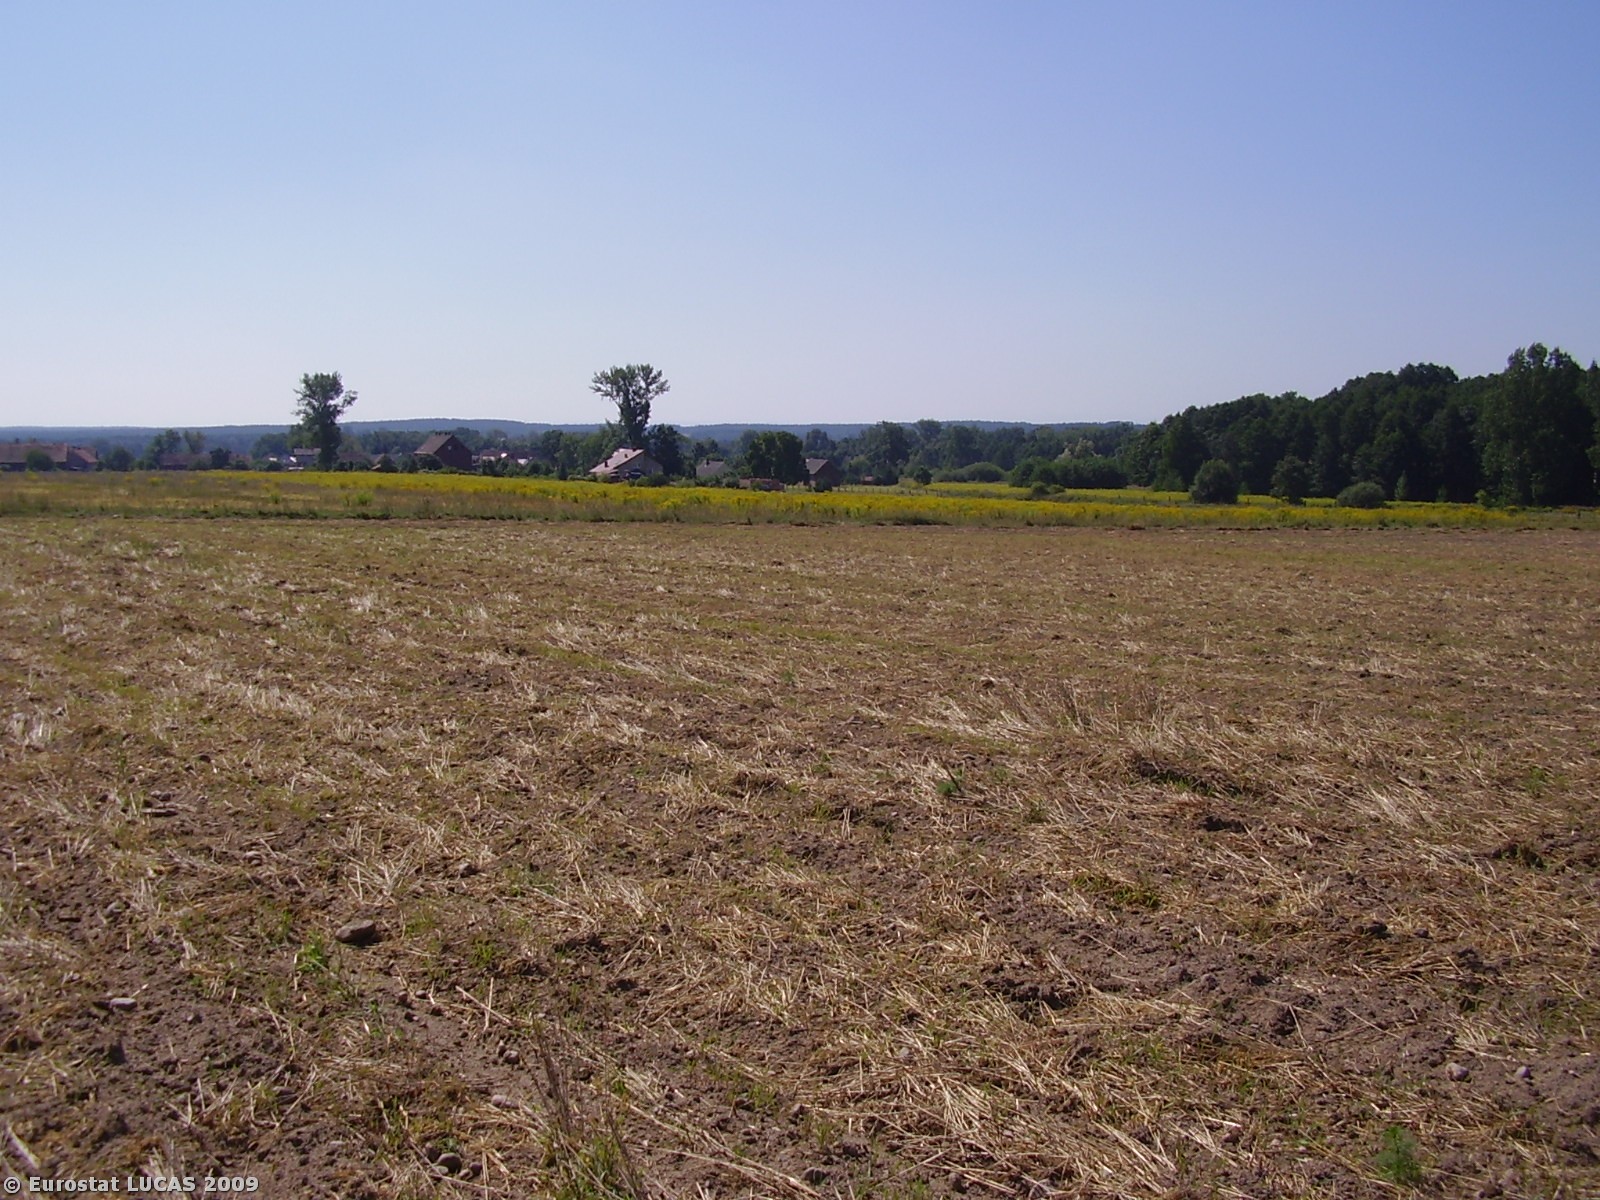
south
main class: Cropland
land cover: Rye
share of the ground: < 10 %
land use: Agriculture (excluding fallow land and kitchen gardens)
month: August
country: PL
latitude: 51.3906
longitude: 16.1140
